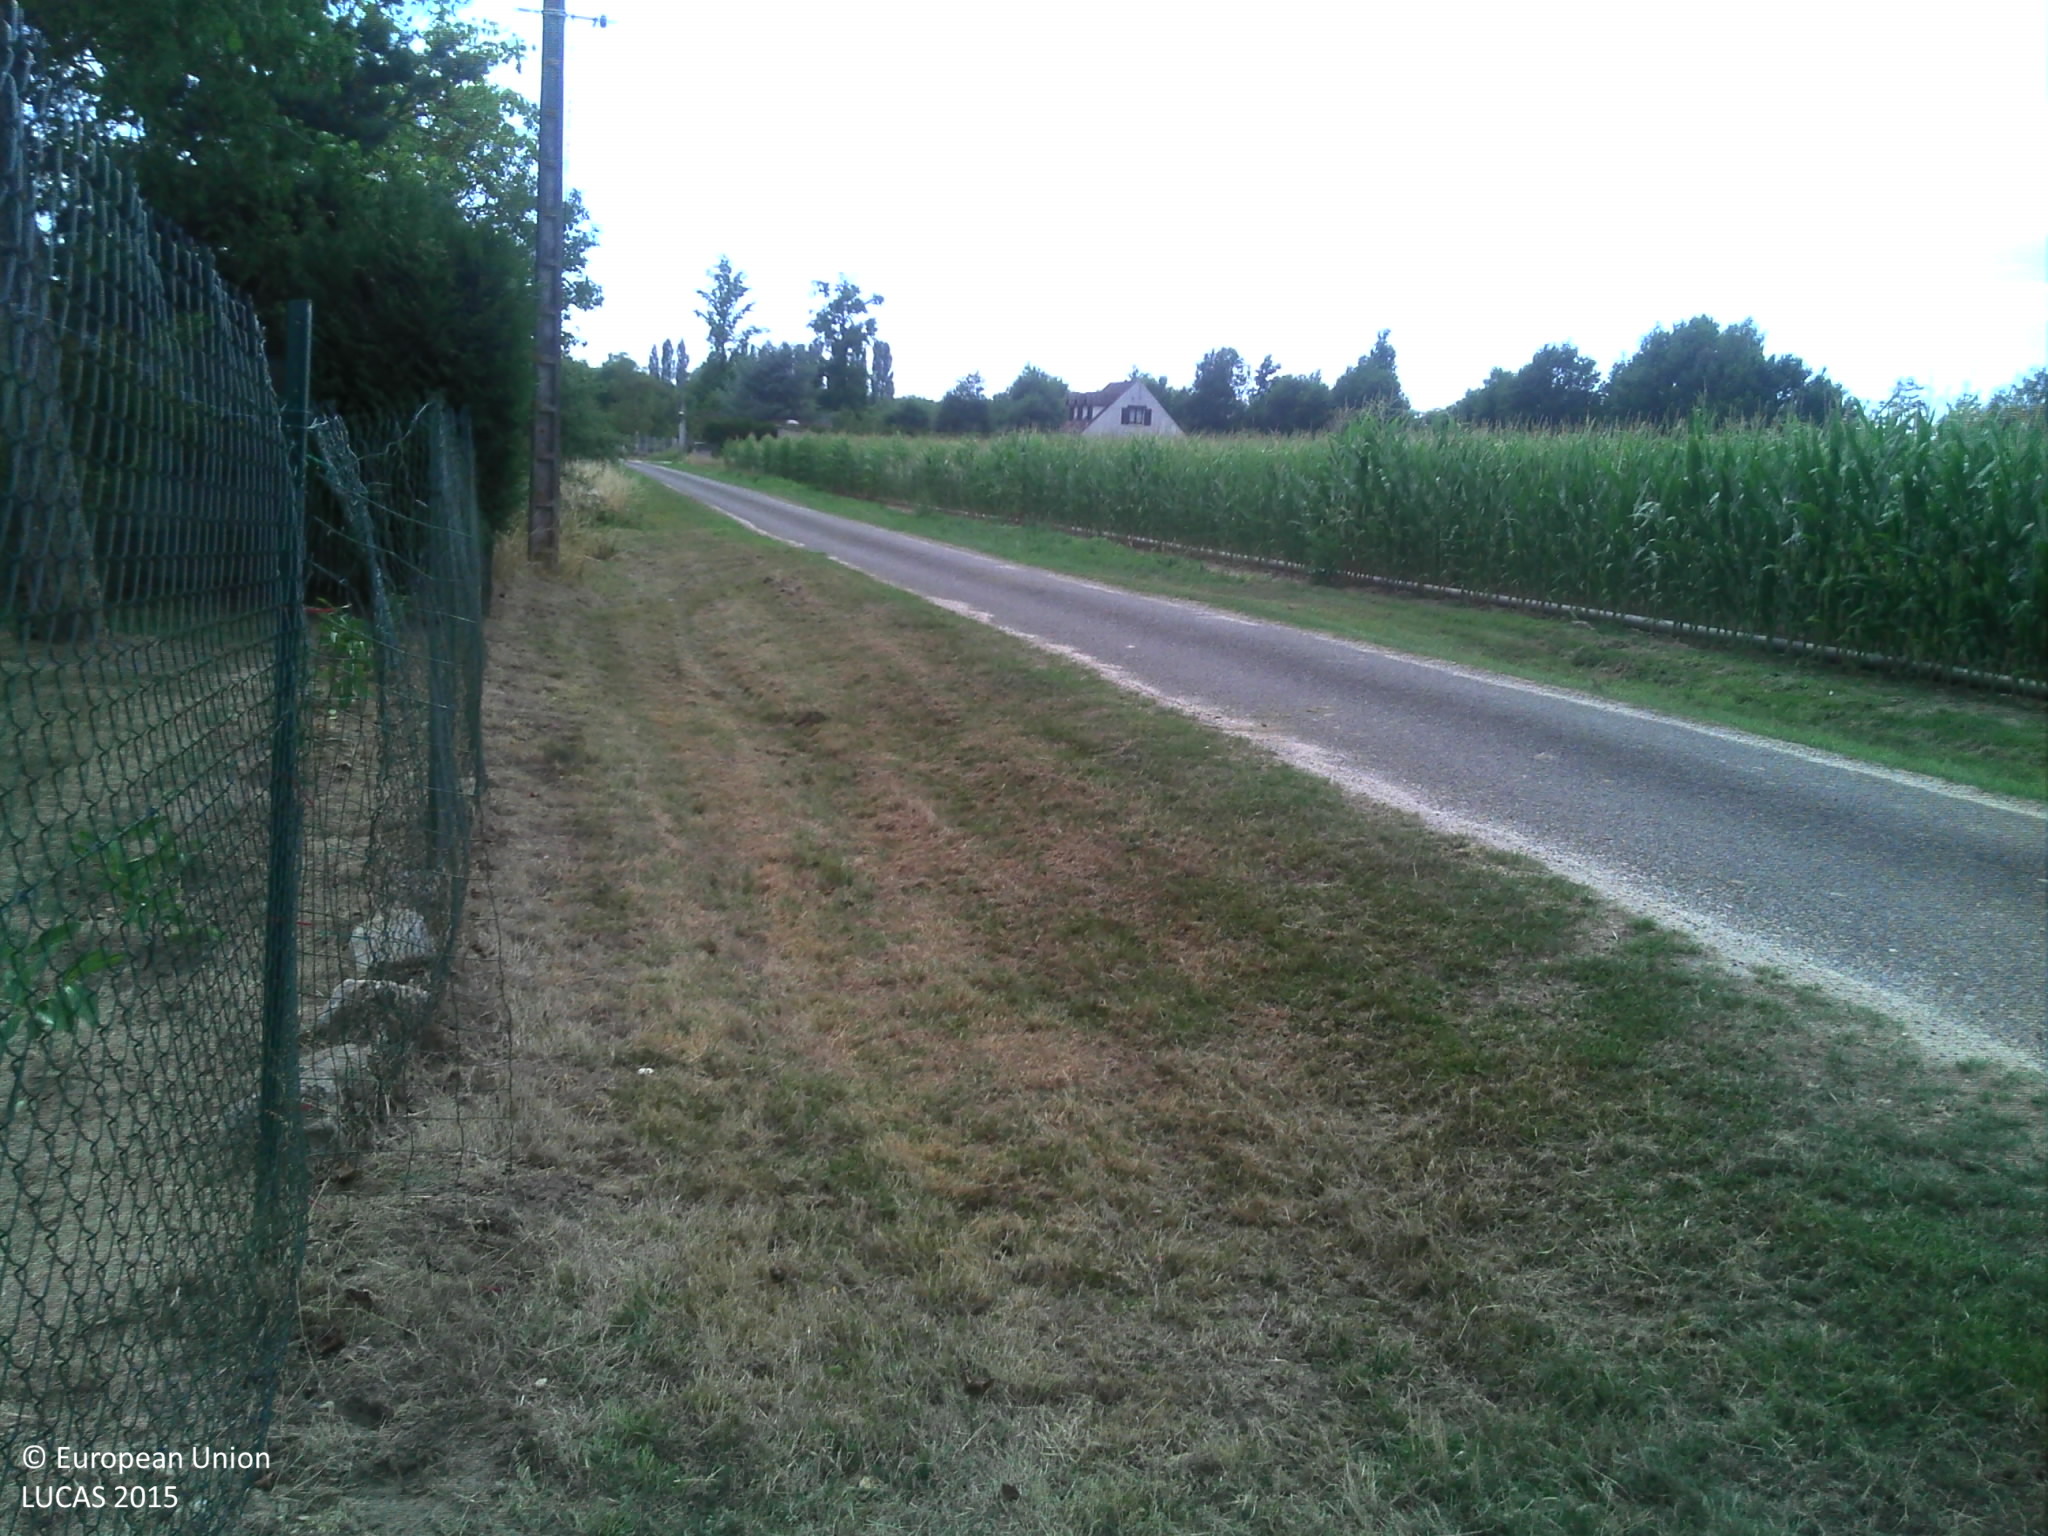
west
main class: Grassland
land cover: Grassland with sparse tree/shrub cover
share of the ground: > 75 %
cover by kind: herbaceous plants 95 %, broadleaved forest trees 5 %
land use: Residential
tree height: > 5 m
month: August
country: FR
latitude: 48.0434
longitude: 2.0334
